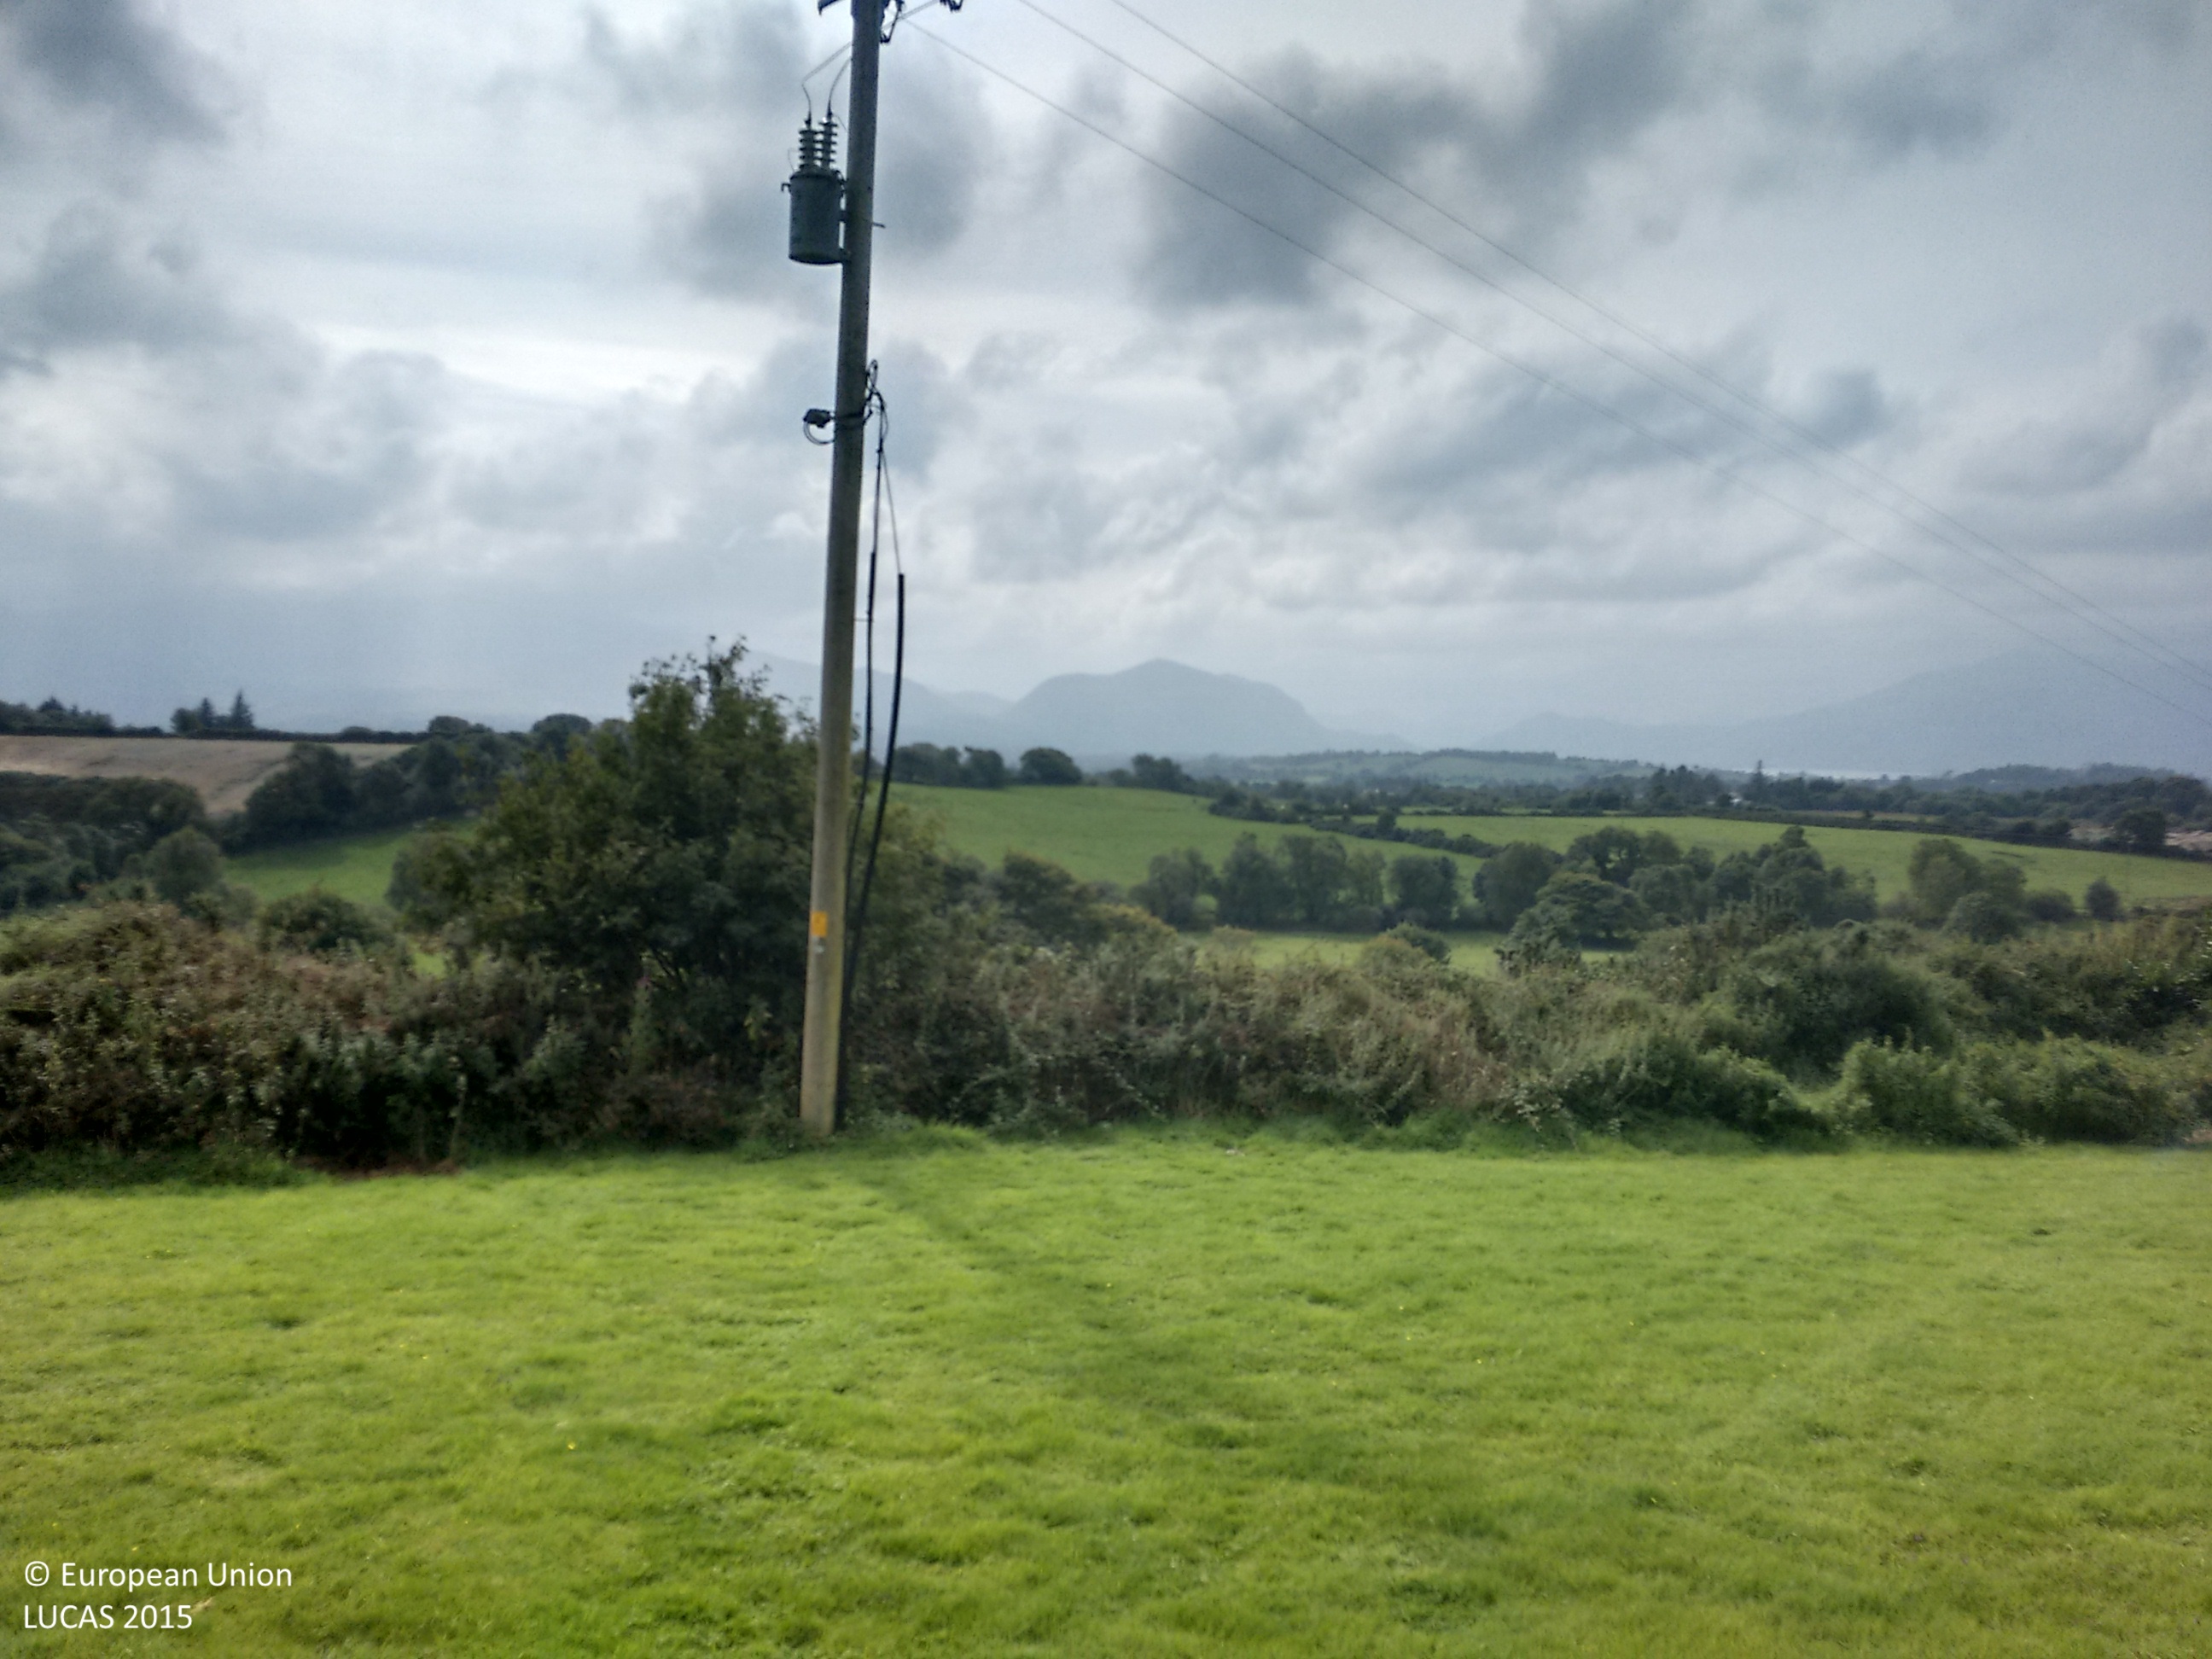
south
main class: Grassland
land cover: Grassland without tree/shrub cover
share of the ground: > 75 %
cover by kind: herbaceous plants 80 %
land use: Residential
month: September
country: IE
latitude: 52.0621
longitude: -9.4404
